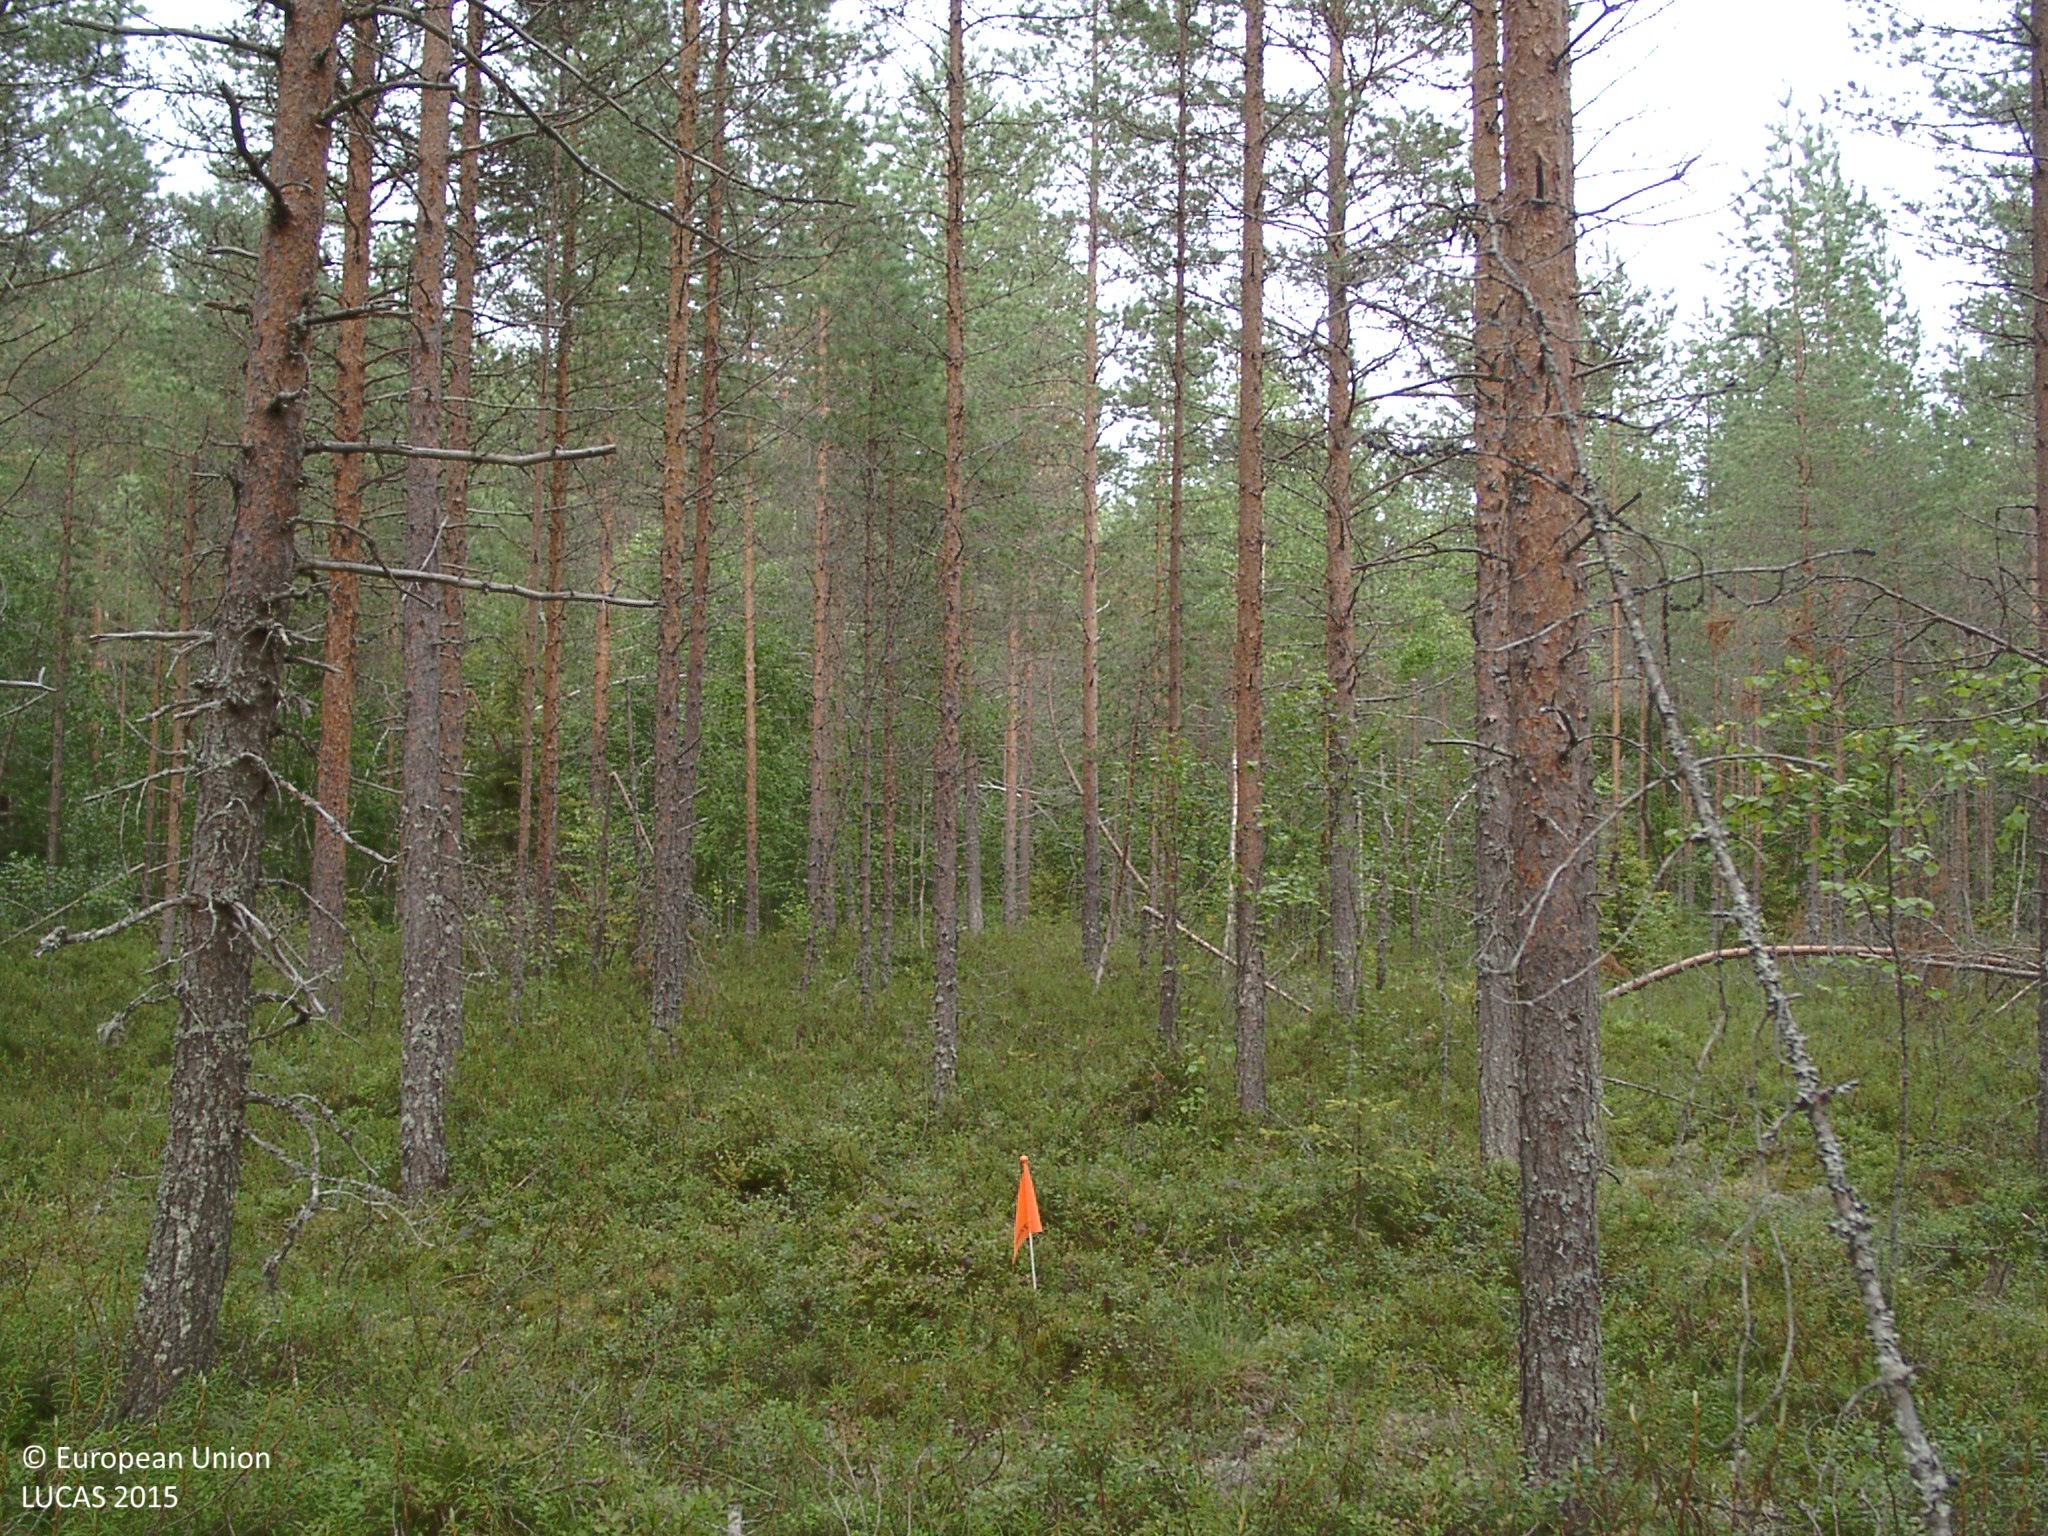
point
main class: Woodland
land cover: Pine dominated coniferous woodland
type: mire and swamp forests
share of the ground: 50 - 75 %
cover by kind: coniferous forest trees 55 %, shrubs 30 %, lichens and mosses 10 %, broadleaved forest trees 5 %
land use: Forestry
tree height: > 5 m
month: August
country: FI
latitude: 62.9846
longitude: 24.7521
